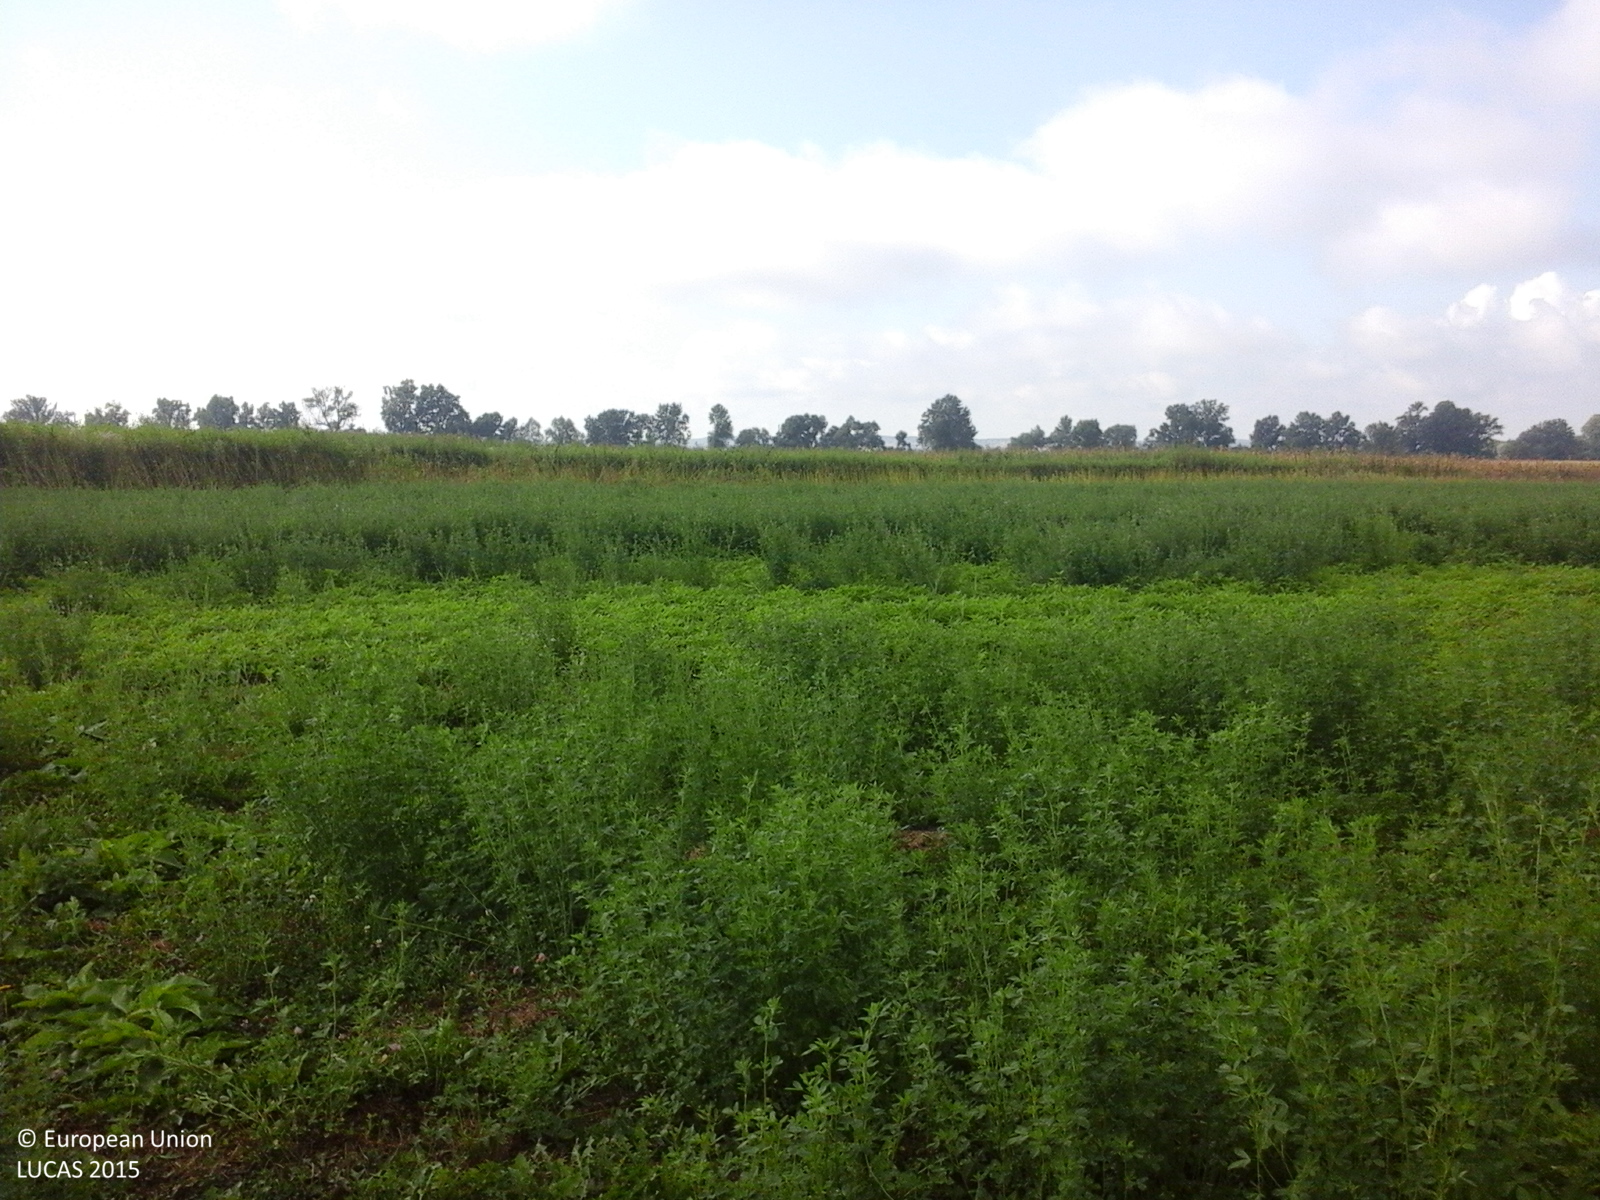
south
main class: Cropland
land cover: Lucerne
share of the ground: > 75 %
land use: Agriculture (excluding fallow land and kitchen gardens)
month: September
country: RO
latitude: 47.6947
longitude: 23.3839
